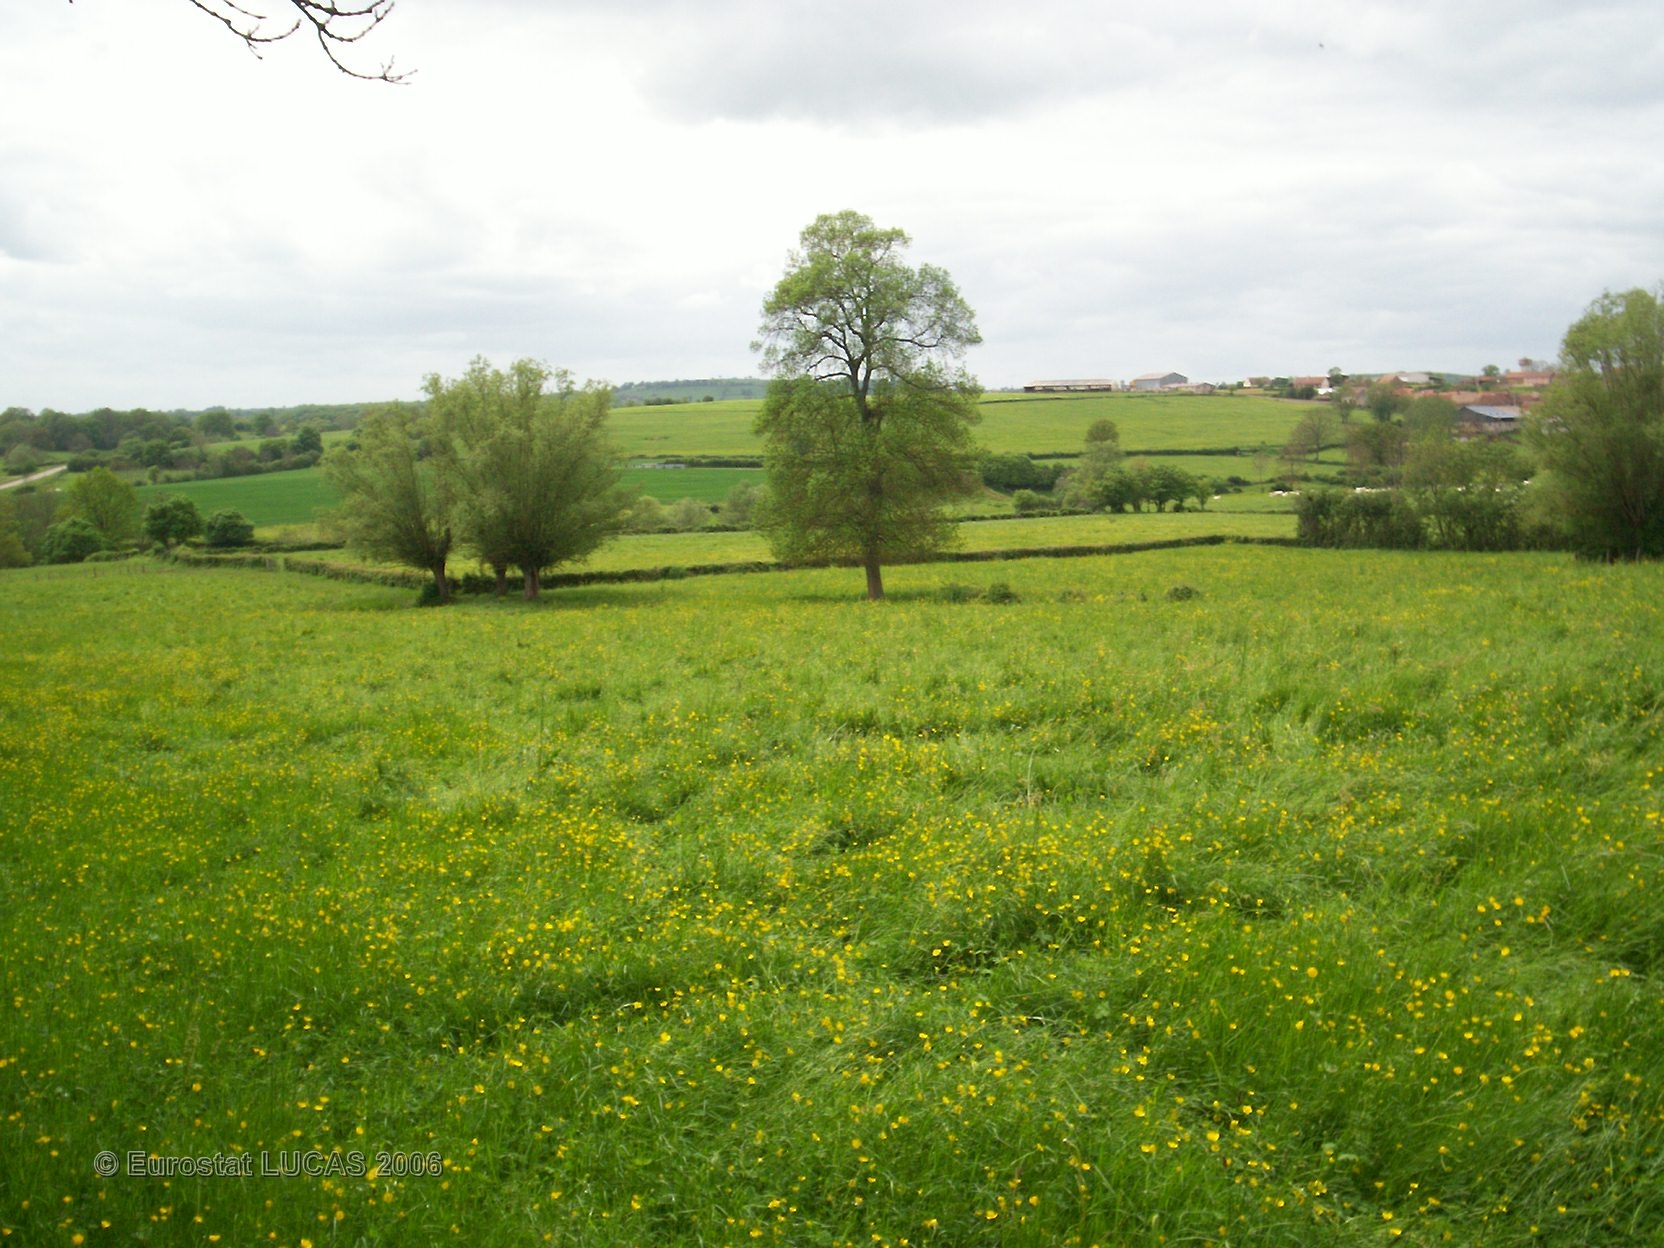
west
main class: Grassland
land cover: Grassland without tree/shrub cover
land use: Agriculture (excluding fallow land and kitchen gardens)
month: May
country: FR
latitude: 47.1189
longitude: 4.6358
